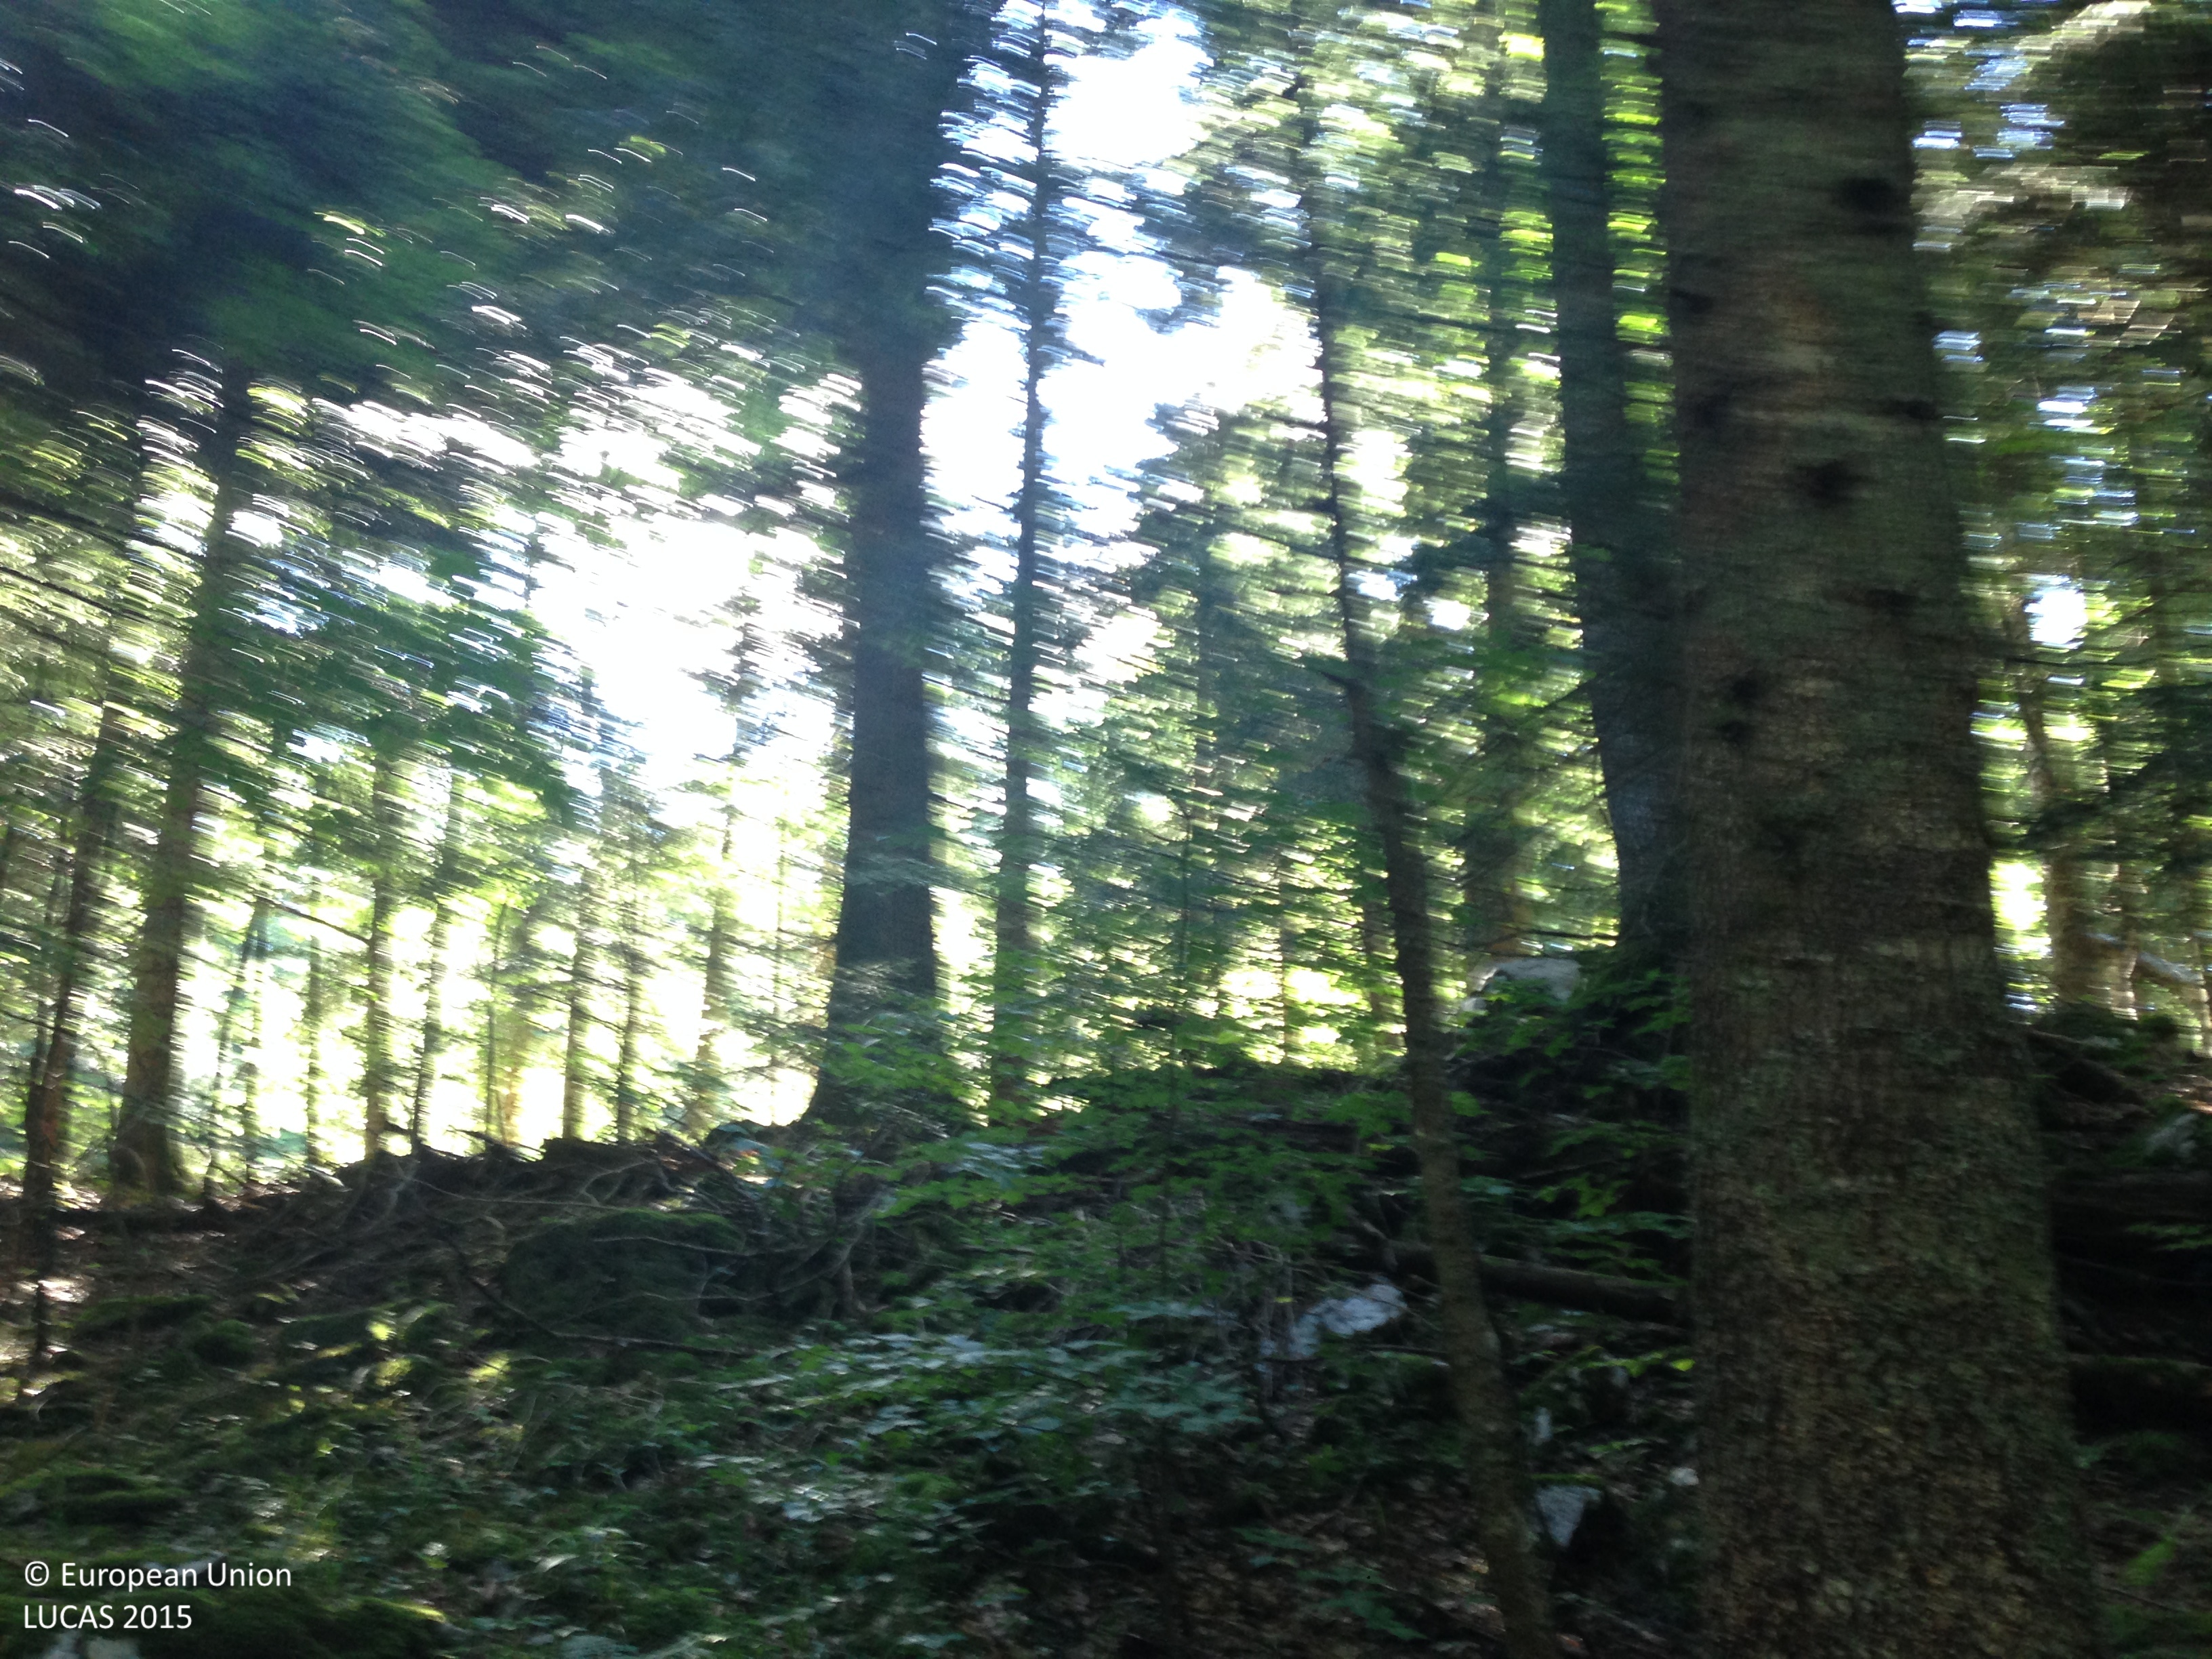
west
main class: Woodland
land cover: Other mixed woodland
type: thermophilous deciduous forest
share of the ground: > 75 %
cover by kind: broadleaved forest trees 45 %, coniferous forest trees 30 %, herbaceous plants 10 %, shrubs 5 %, lichens and mosses 5 %, unconsolidated bare surface 5 %
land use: Forestry
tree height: > 5 m
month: June
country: HR
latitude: 44.6385
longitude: 15.8311
